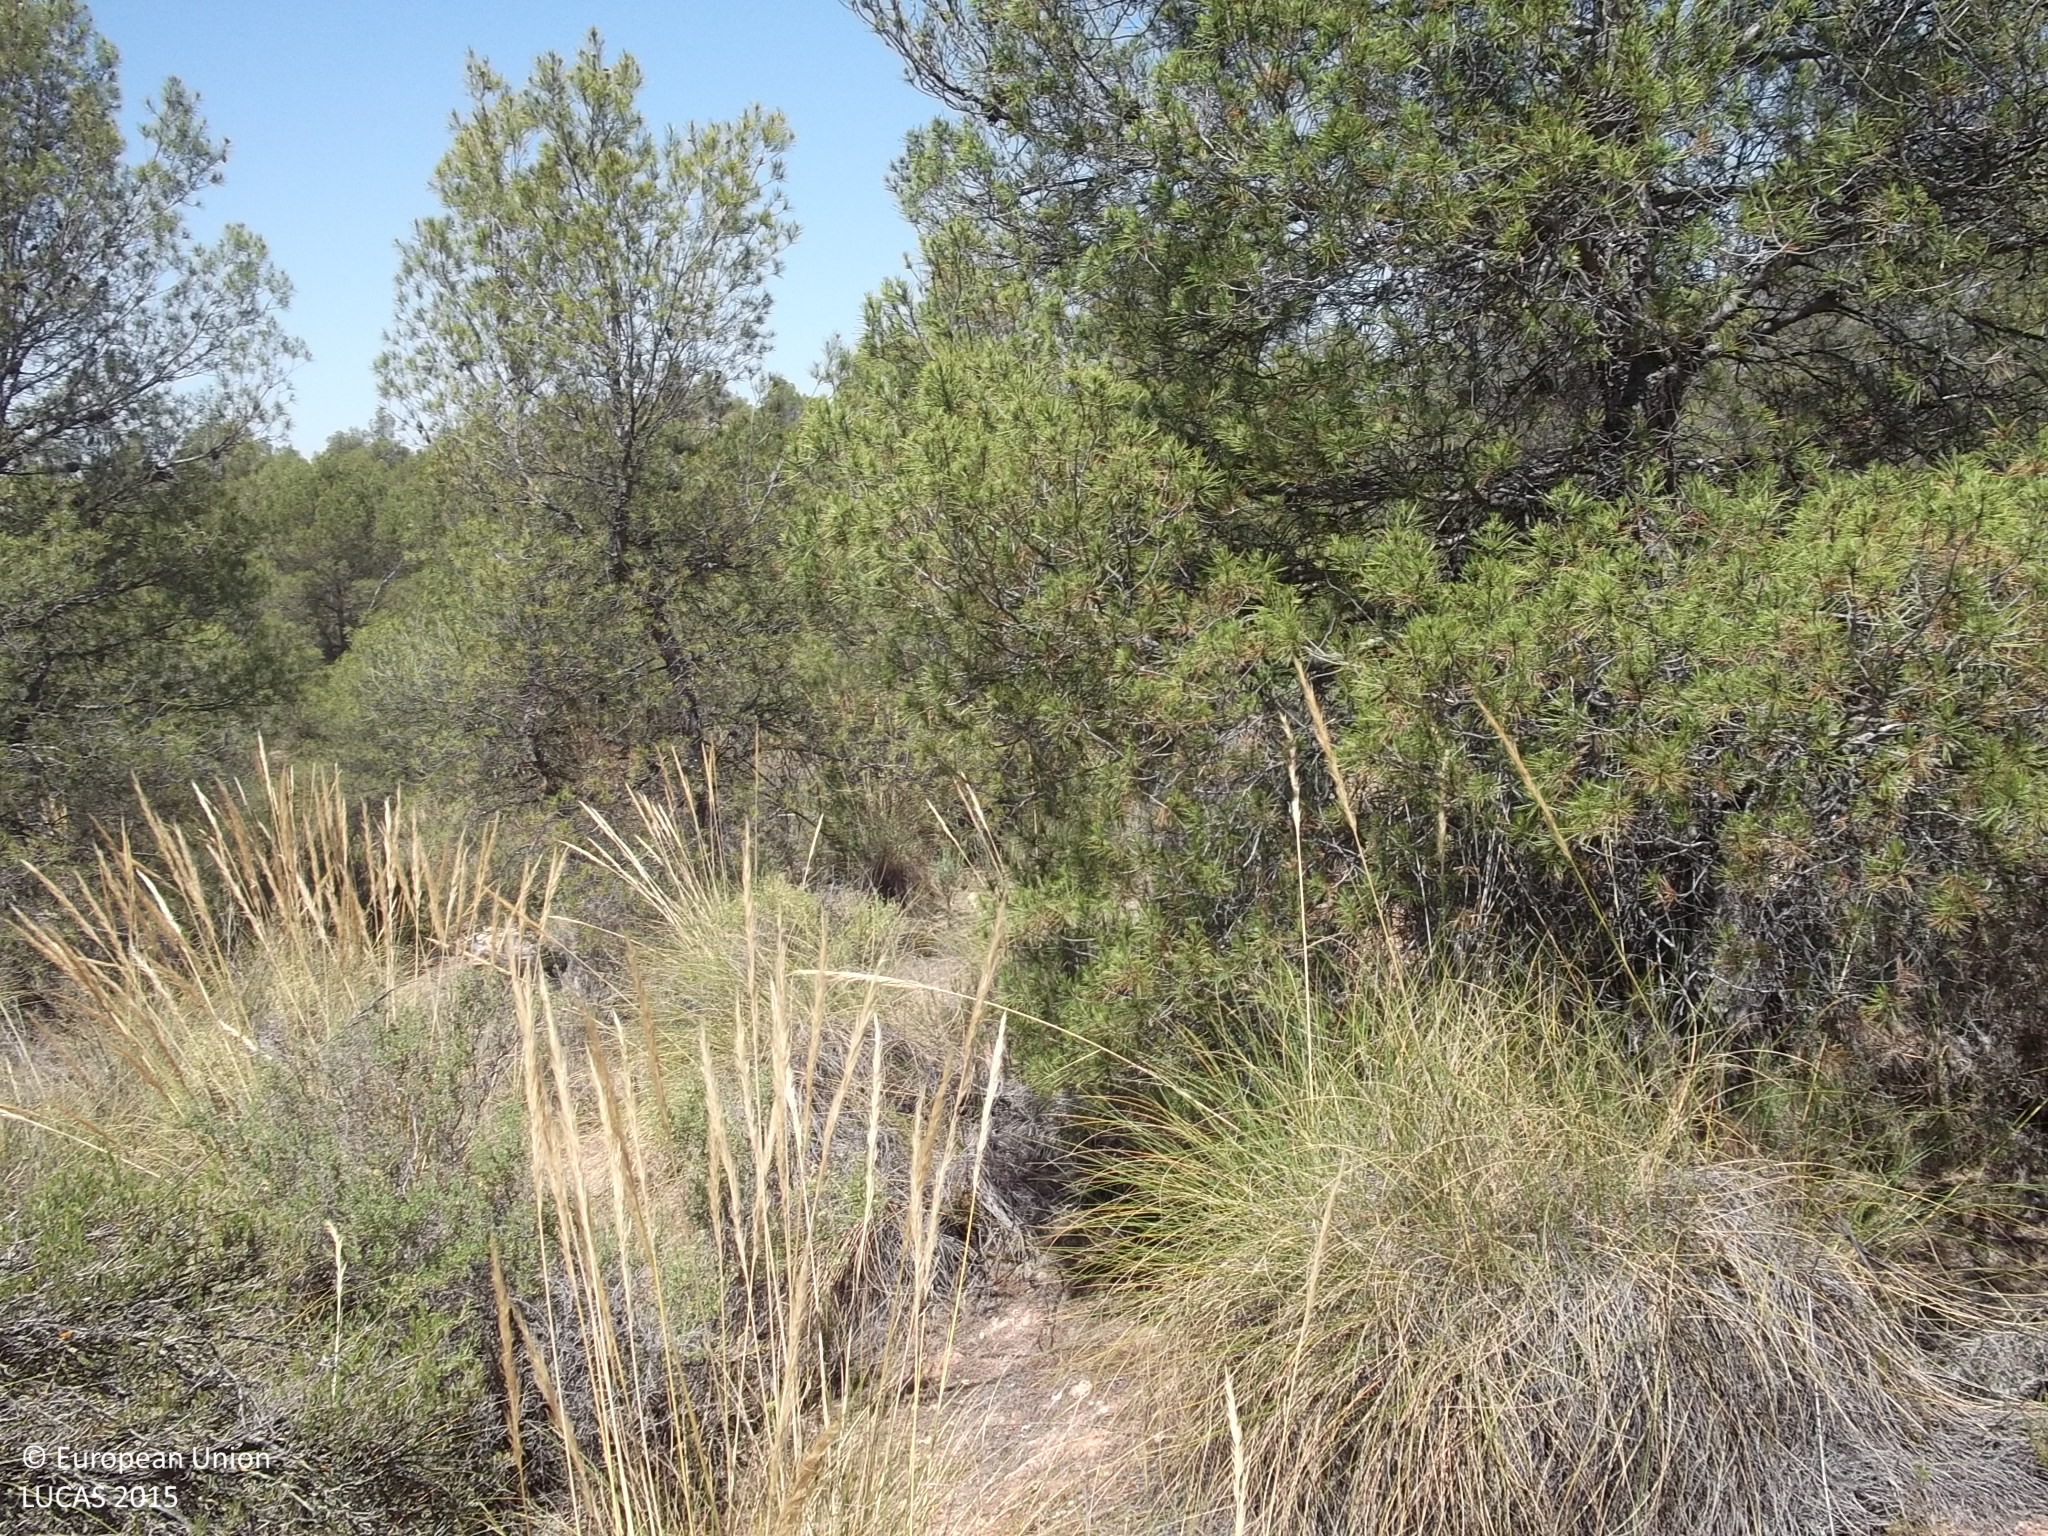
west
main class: Woodland
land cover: Pine dominated coniferous woodland
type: coniferous forest of the mediterranean region
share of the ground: 25 - 50 %
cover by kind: coniferous forest trees 30 %, shrubs 30 %, herbaceous plants 20 %, consolidated bare surface 20 %
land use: Semi-natural and natural areas not in use
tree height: > 5 m
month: June
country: ES
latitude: 38.1933
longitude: -1.5550
